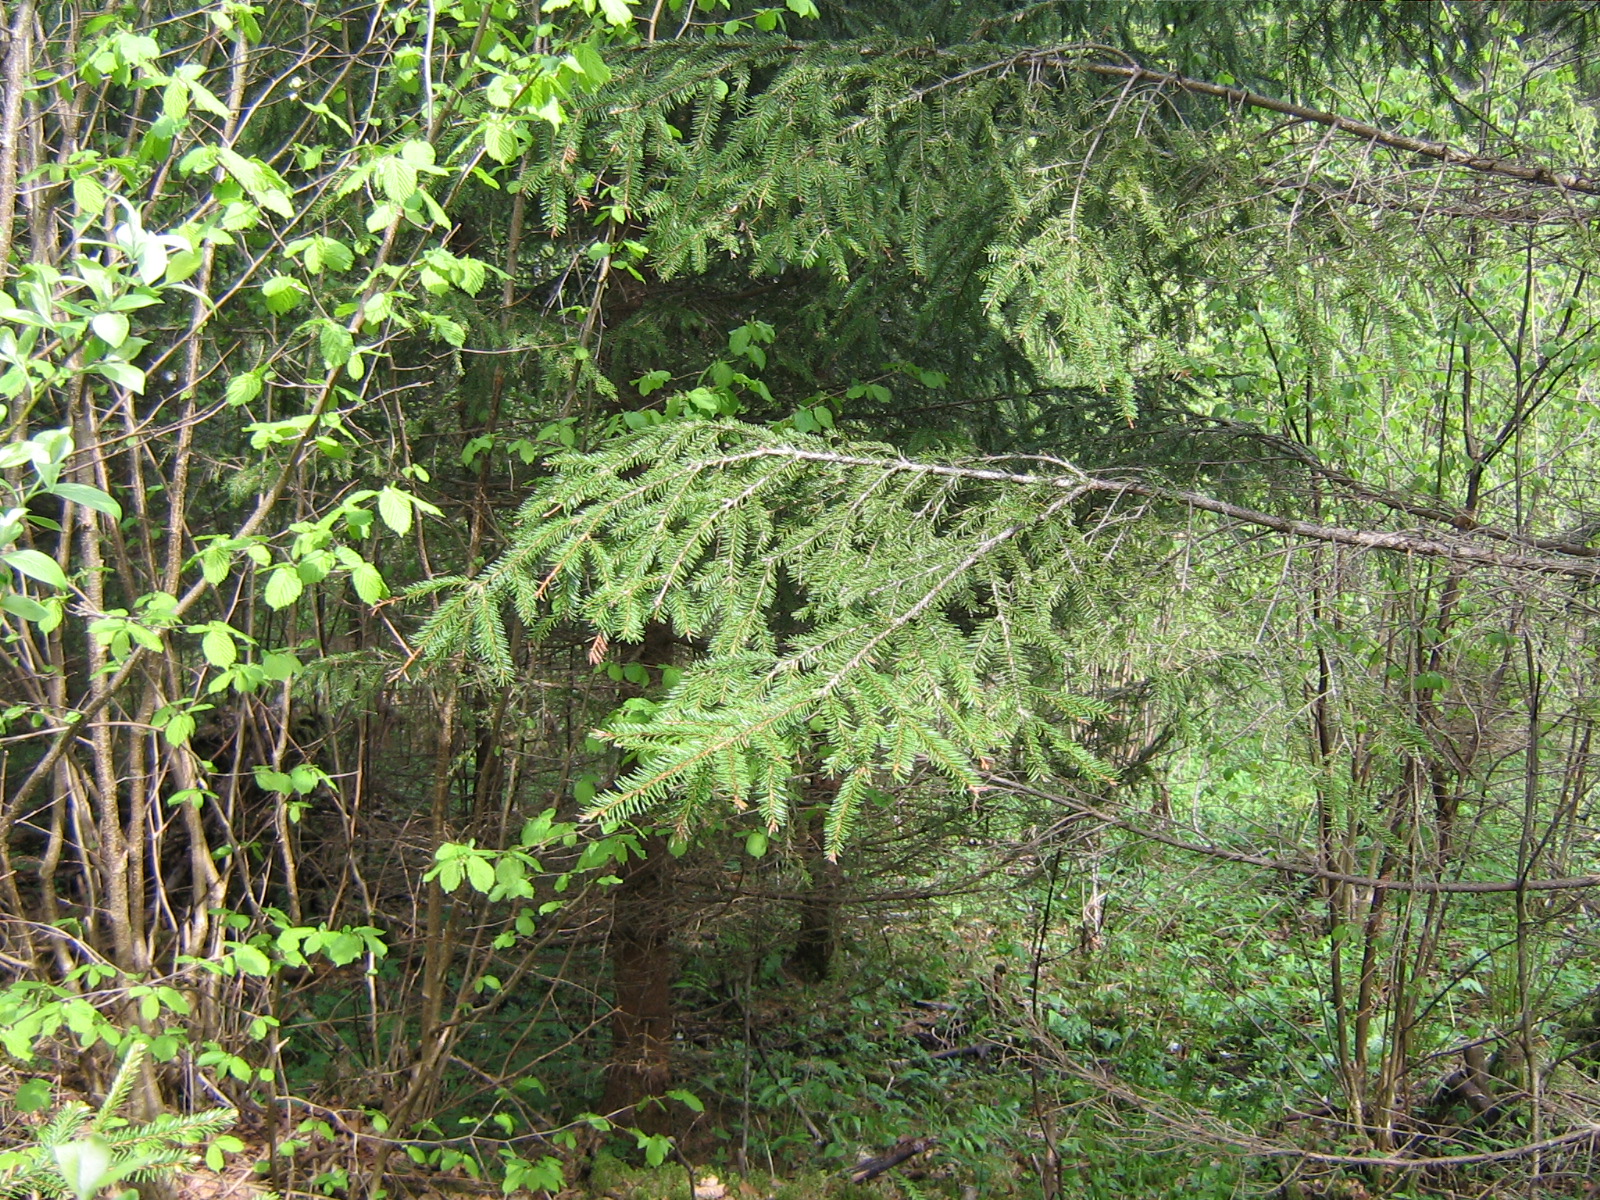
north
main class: Woodland
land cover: Spruce dominated mixed woodland
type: hemiboreal forest and nemoral coniferous forest and mixed broadleaved-coniferous forest
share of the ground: > 75 %
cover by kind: coniferous forest trees 75 %, broadleaved forest trees 25 %
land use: Forestry
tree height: > 5 m
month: May
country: LV
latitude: 57.2161
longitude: 25.5337
